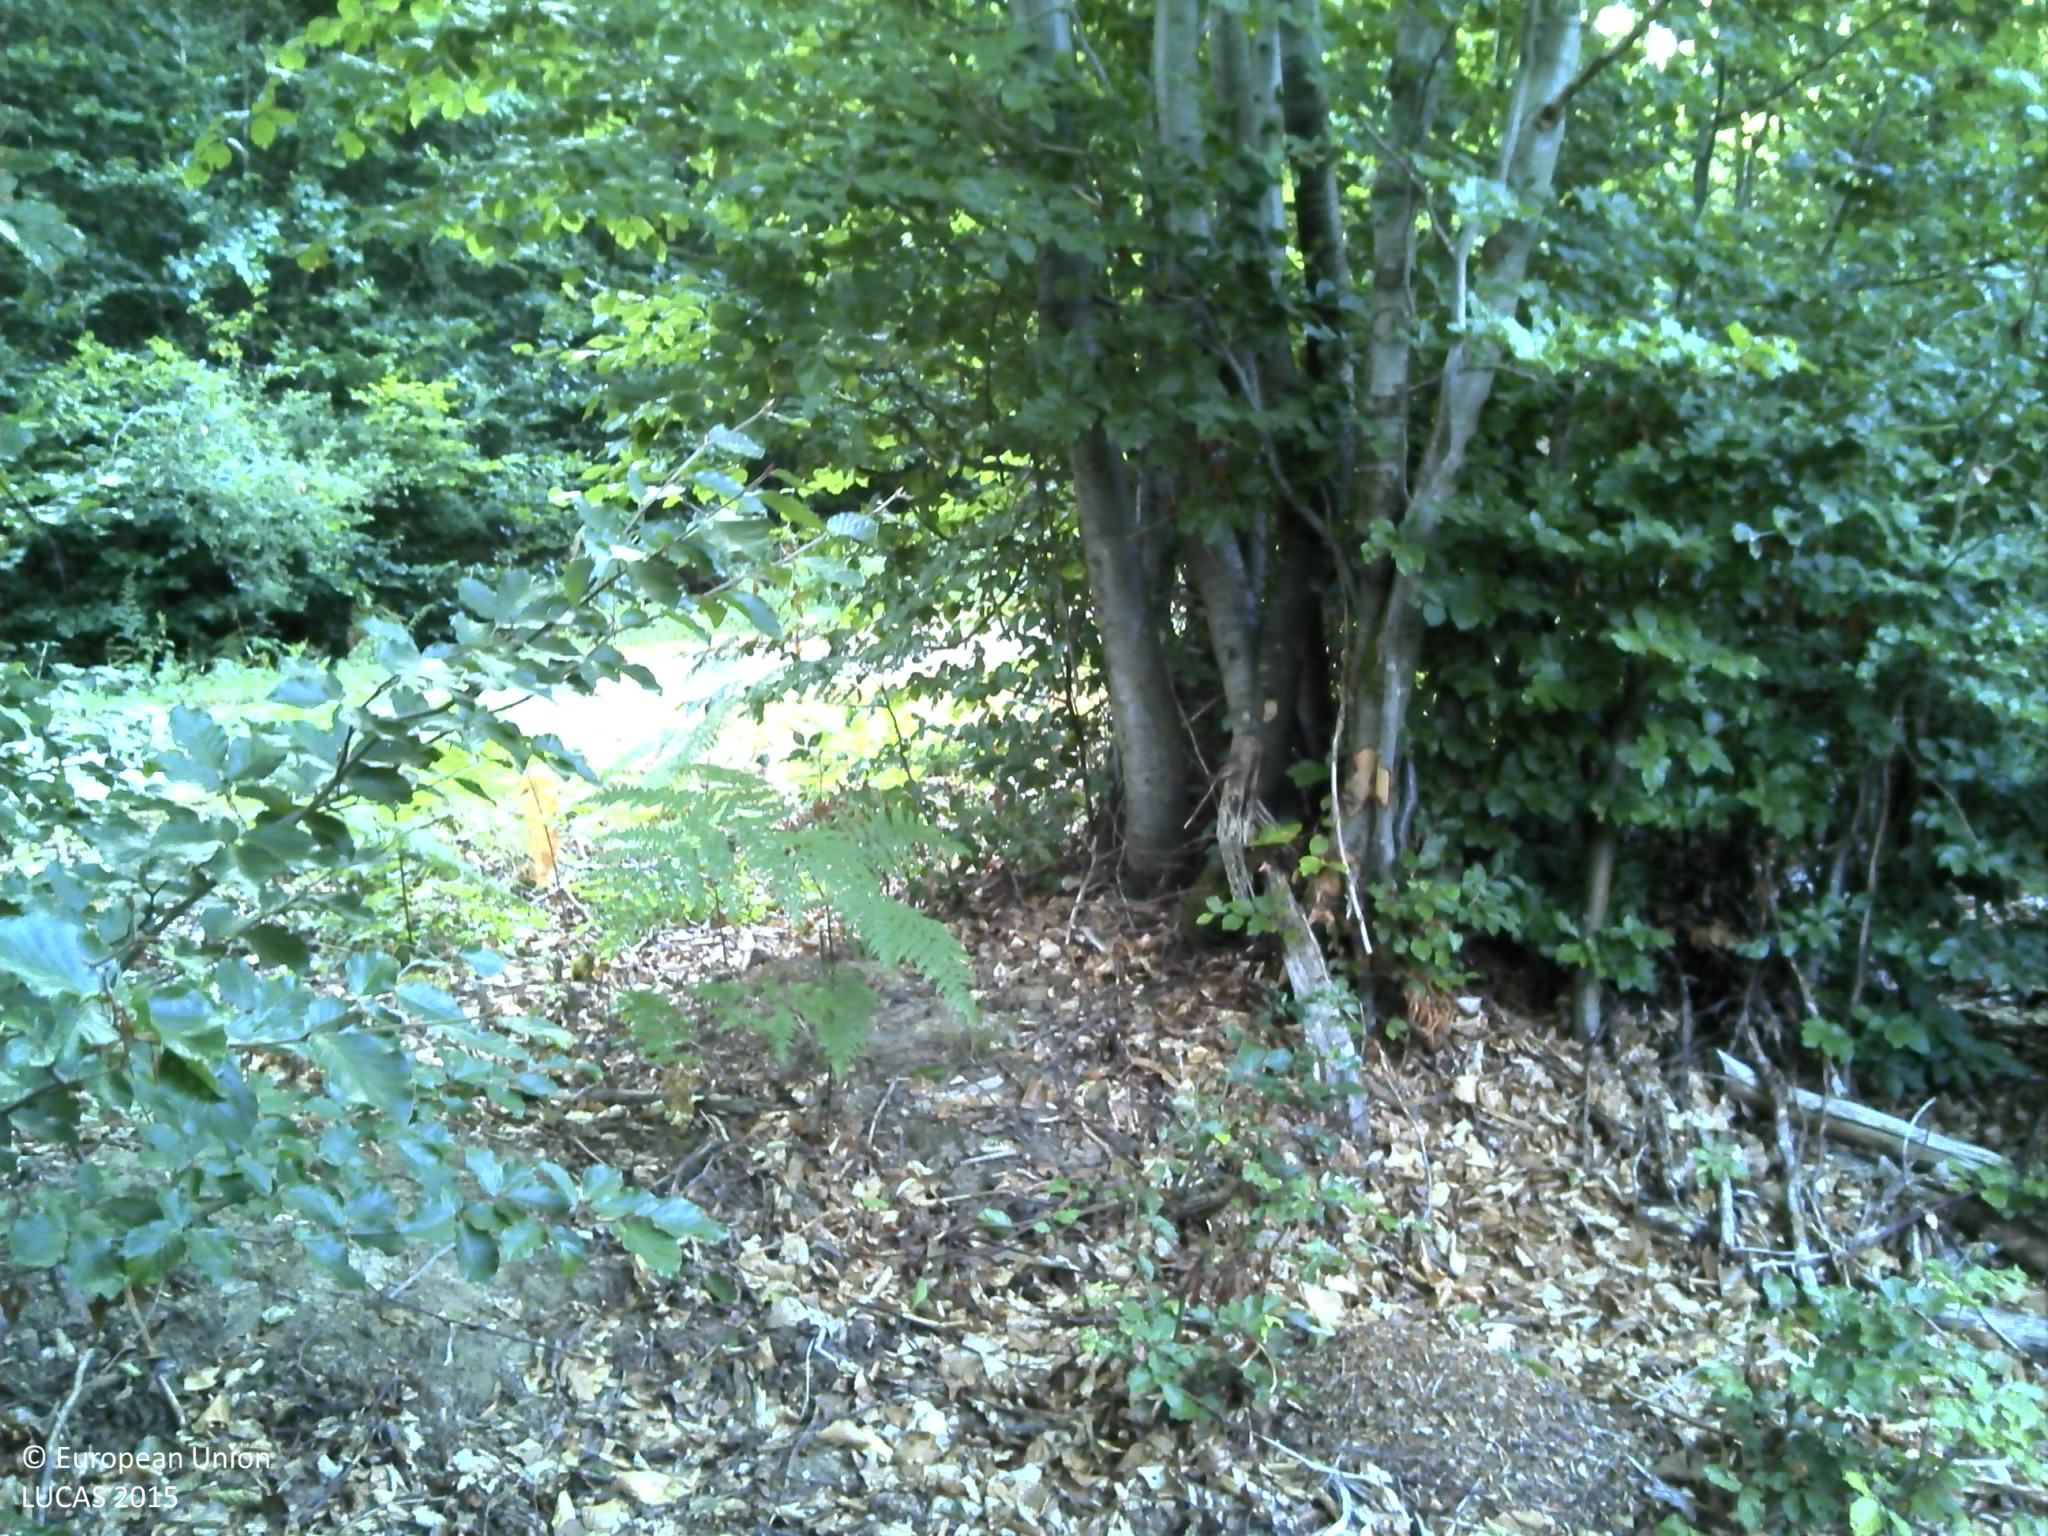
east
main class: Woodland
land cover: Broadleaved woodland
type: beech forest
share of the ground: > 75 %
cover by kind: broadleaved forest trees 90 %, herbaceous plants 5 %, unconsolidated bare surface 5 %
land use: Forestry
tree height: > 5 m
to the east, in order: Broadleaved woodland; Ditches and canals; Grass margins; Tracks; Grass margins; Ditches and canals; Broadleaved woodland
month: July
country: FR
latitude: 48.0294
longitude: 6.1251
